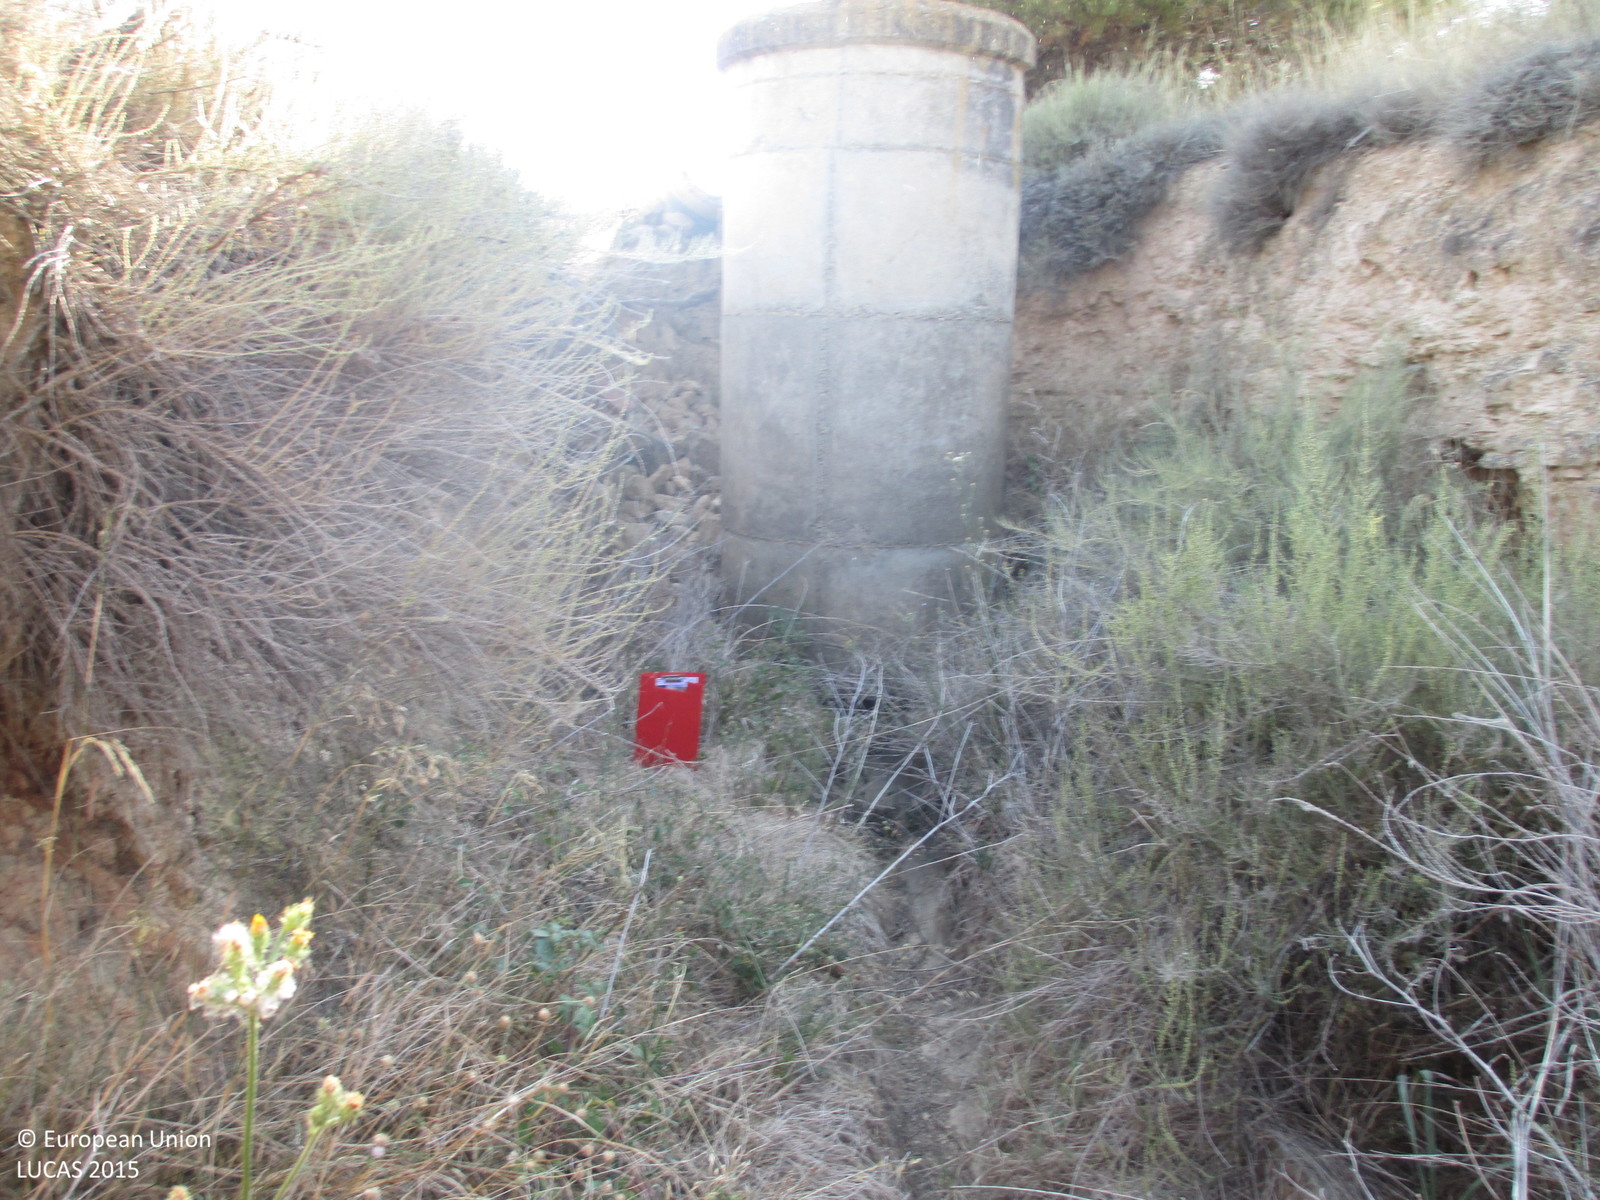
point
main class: Shrubland
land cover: Shrubland without tree cover
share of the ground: > 75 %
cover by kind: herbaceous plants 80 %, shrubs 20 %
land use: Semi-natural and natural areas not in use
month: July
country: ES
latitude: 41.8557
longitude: 0.0693
